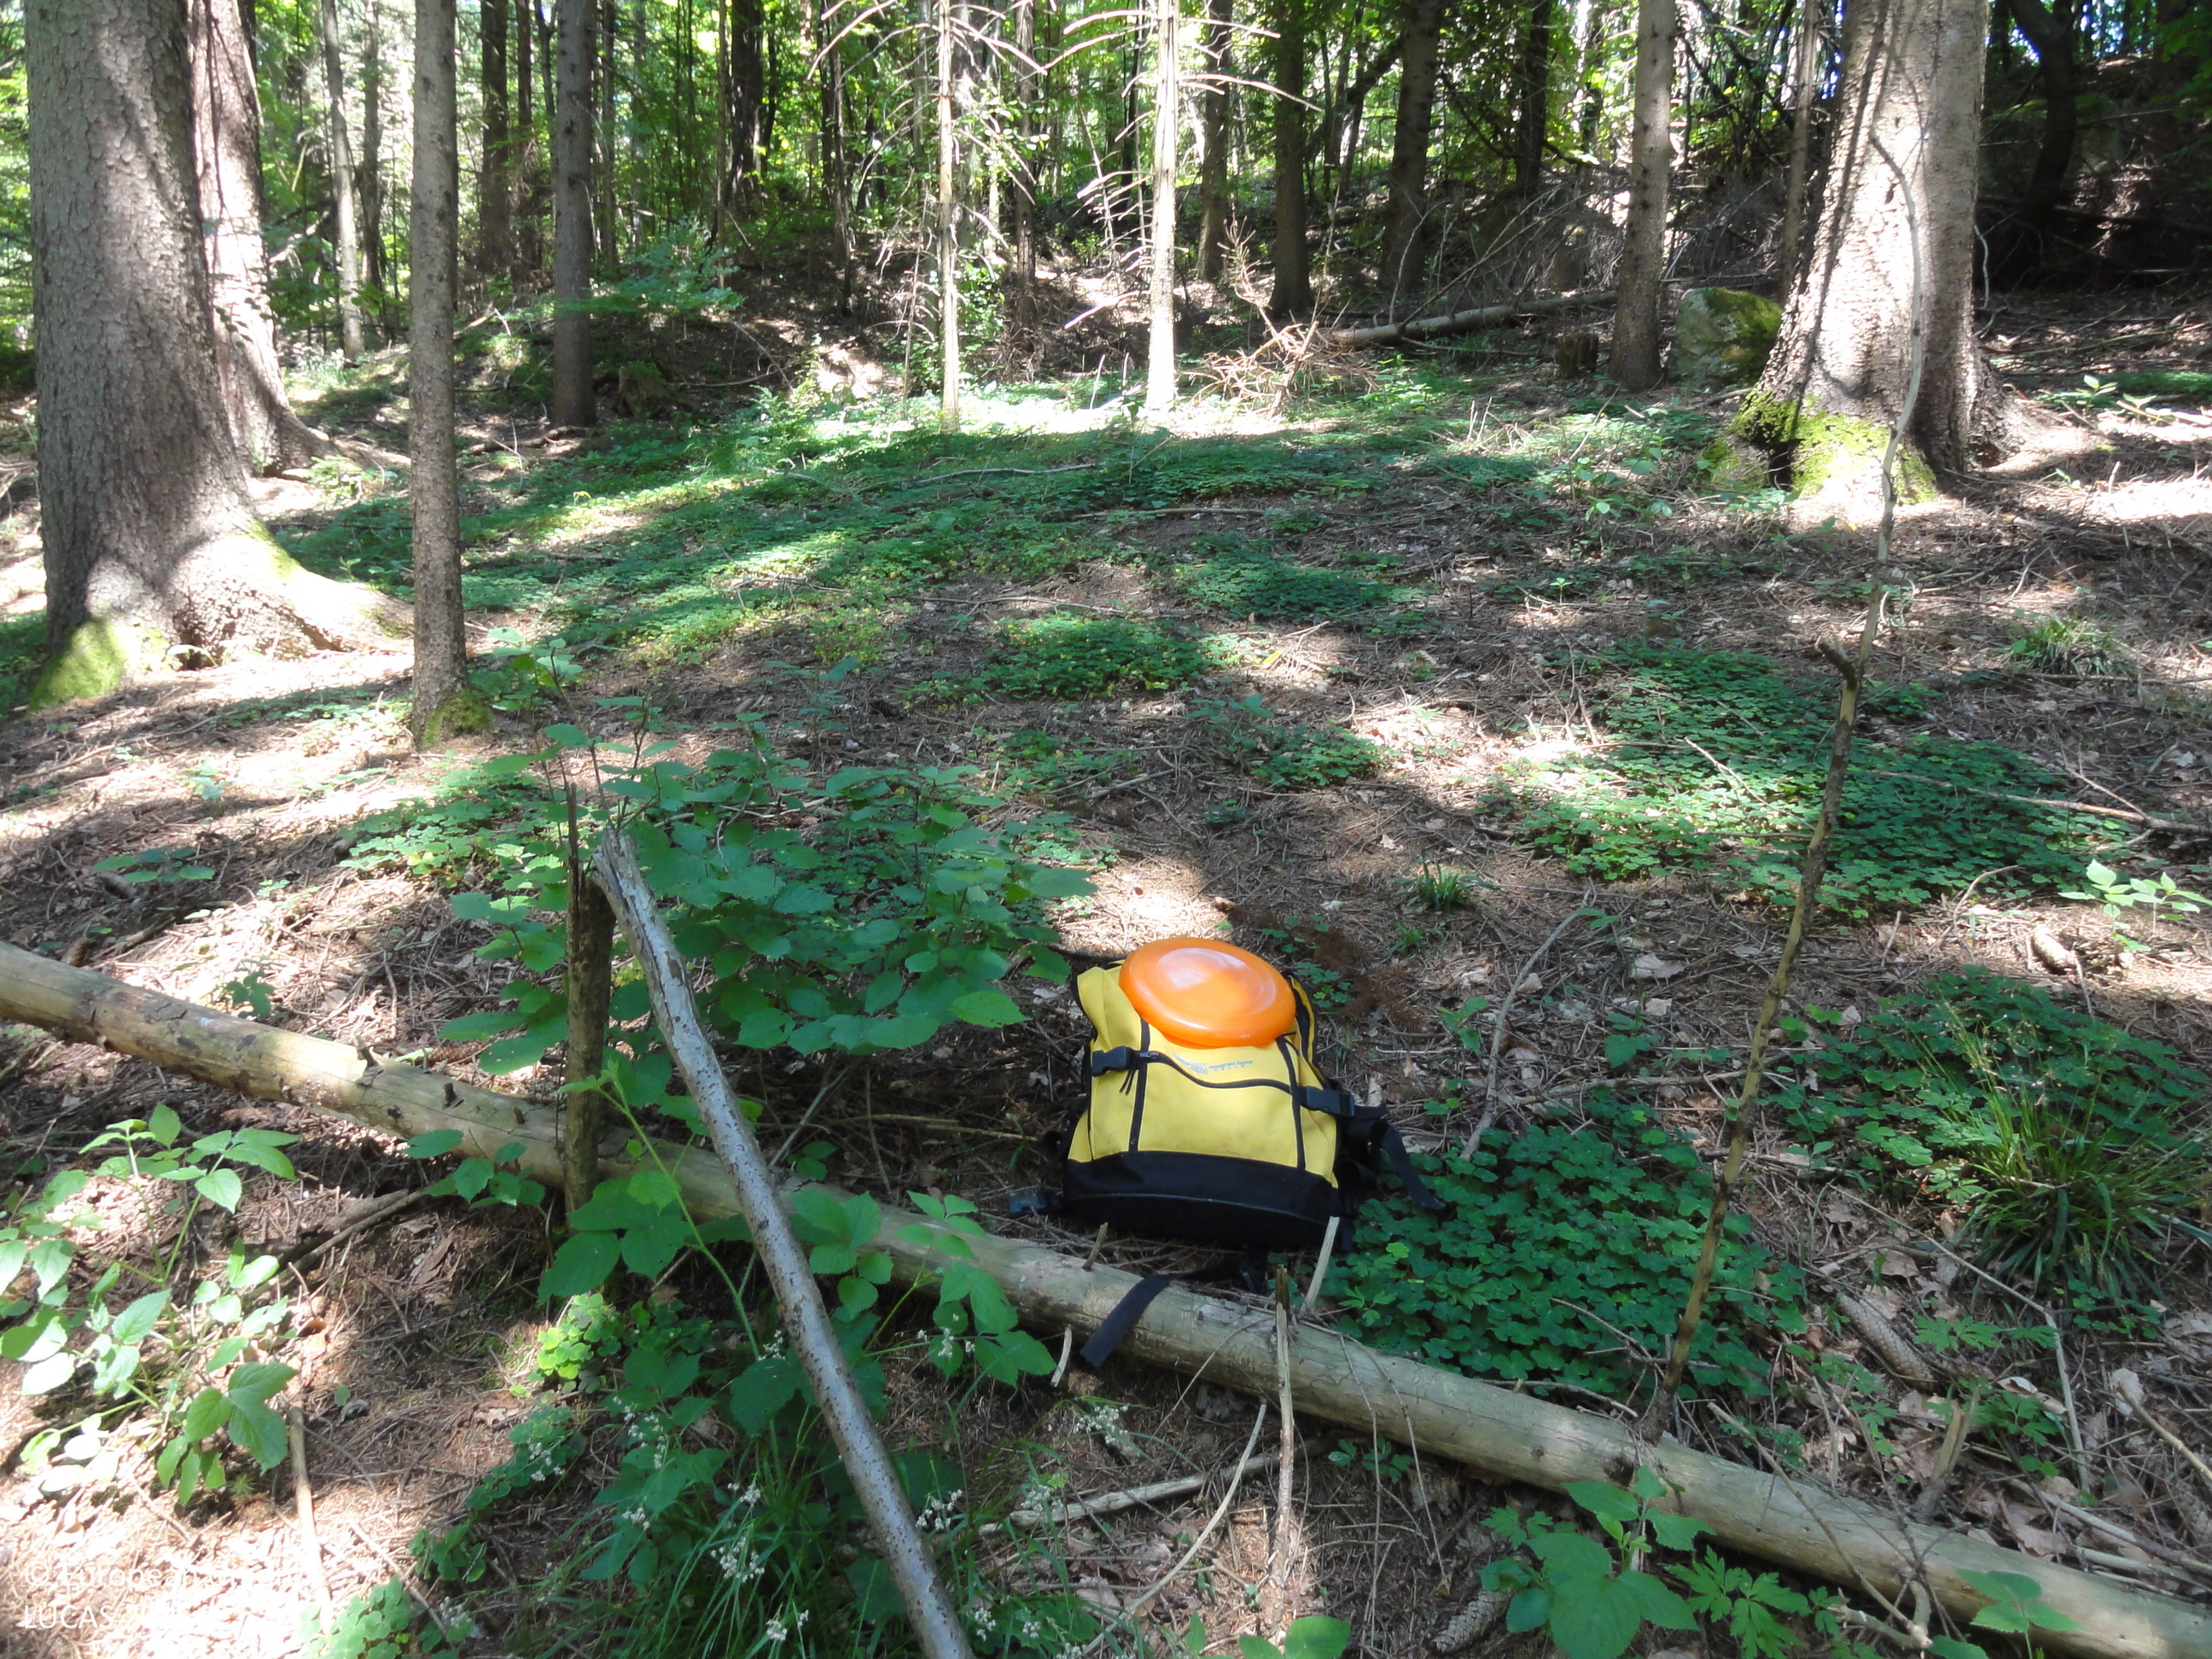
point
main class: Woodland
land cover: Spruce dominated mixed woodland
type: mesophytic deciduous forest
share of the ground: > 75 %
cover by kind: coniferous forest trees 65 %, broadleaved forest trees 35 %
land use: Forestry
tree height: > 5 m
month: June
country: SI
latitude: 46.3544
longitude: 15.4955
